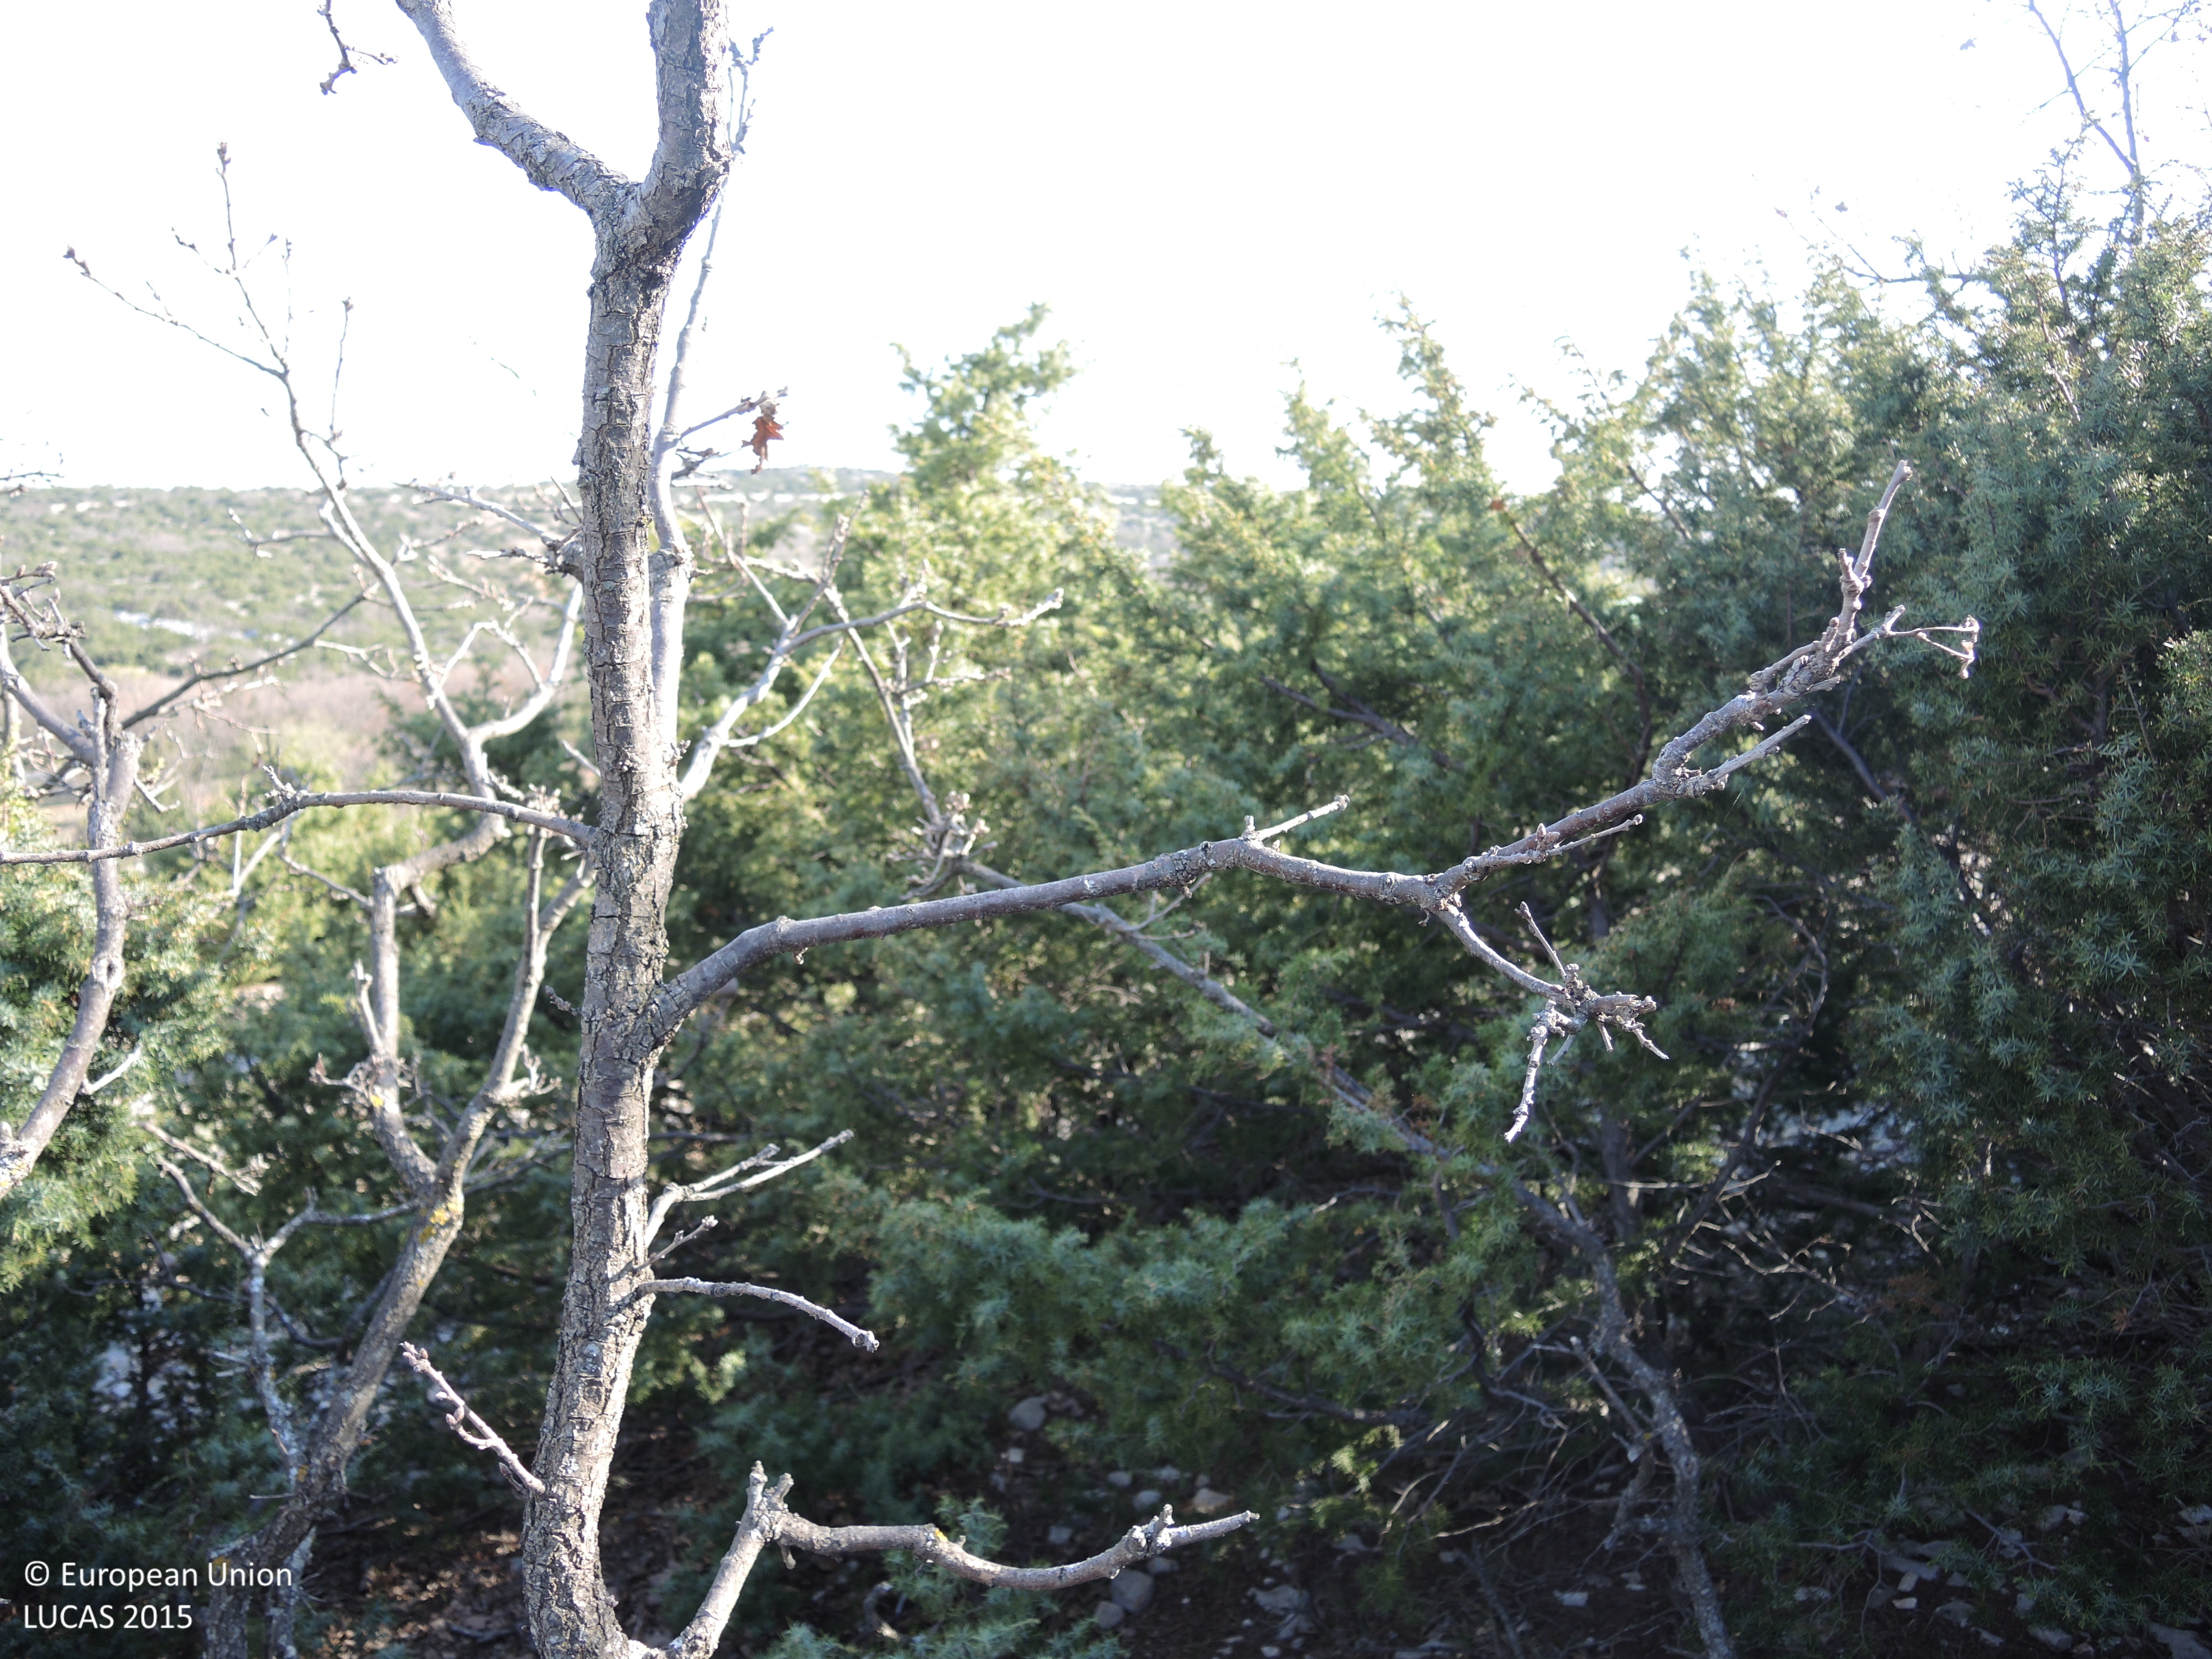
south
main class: Shrubland
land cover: Shrubland with sparse tree cover
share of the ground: 25 - 50 %
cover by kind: unconsolidated bare surface 35 %, shrubs 30 %, herbaceous plants 20 %, consolidated bare surface 10 %, broadleaved forest trees 5 %
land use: Semi-natural and natural areas not in use
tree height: < 5 m
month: April
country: HR
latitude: 44.0495
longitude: 15.6959
